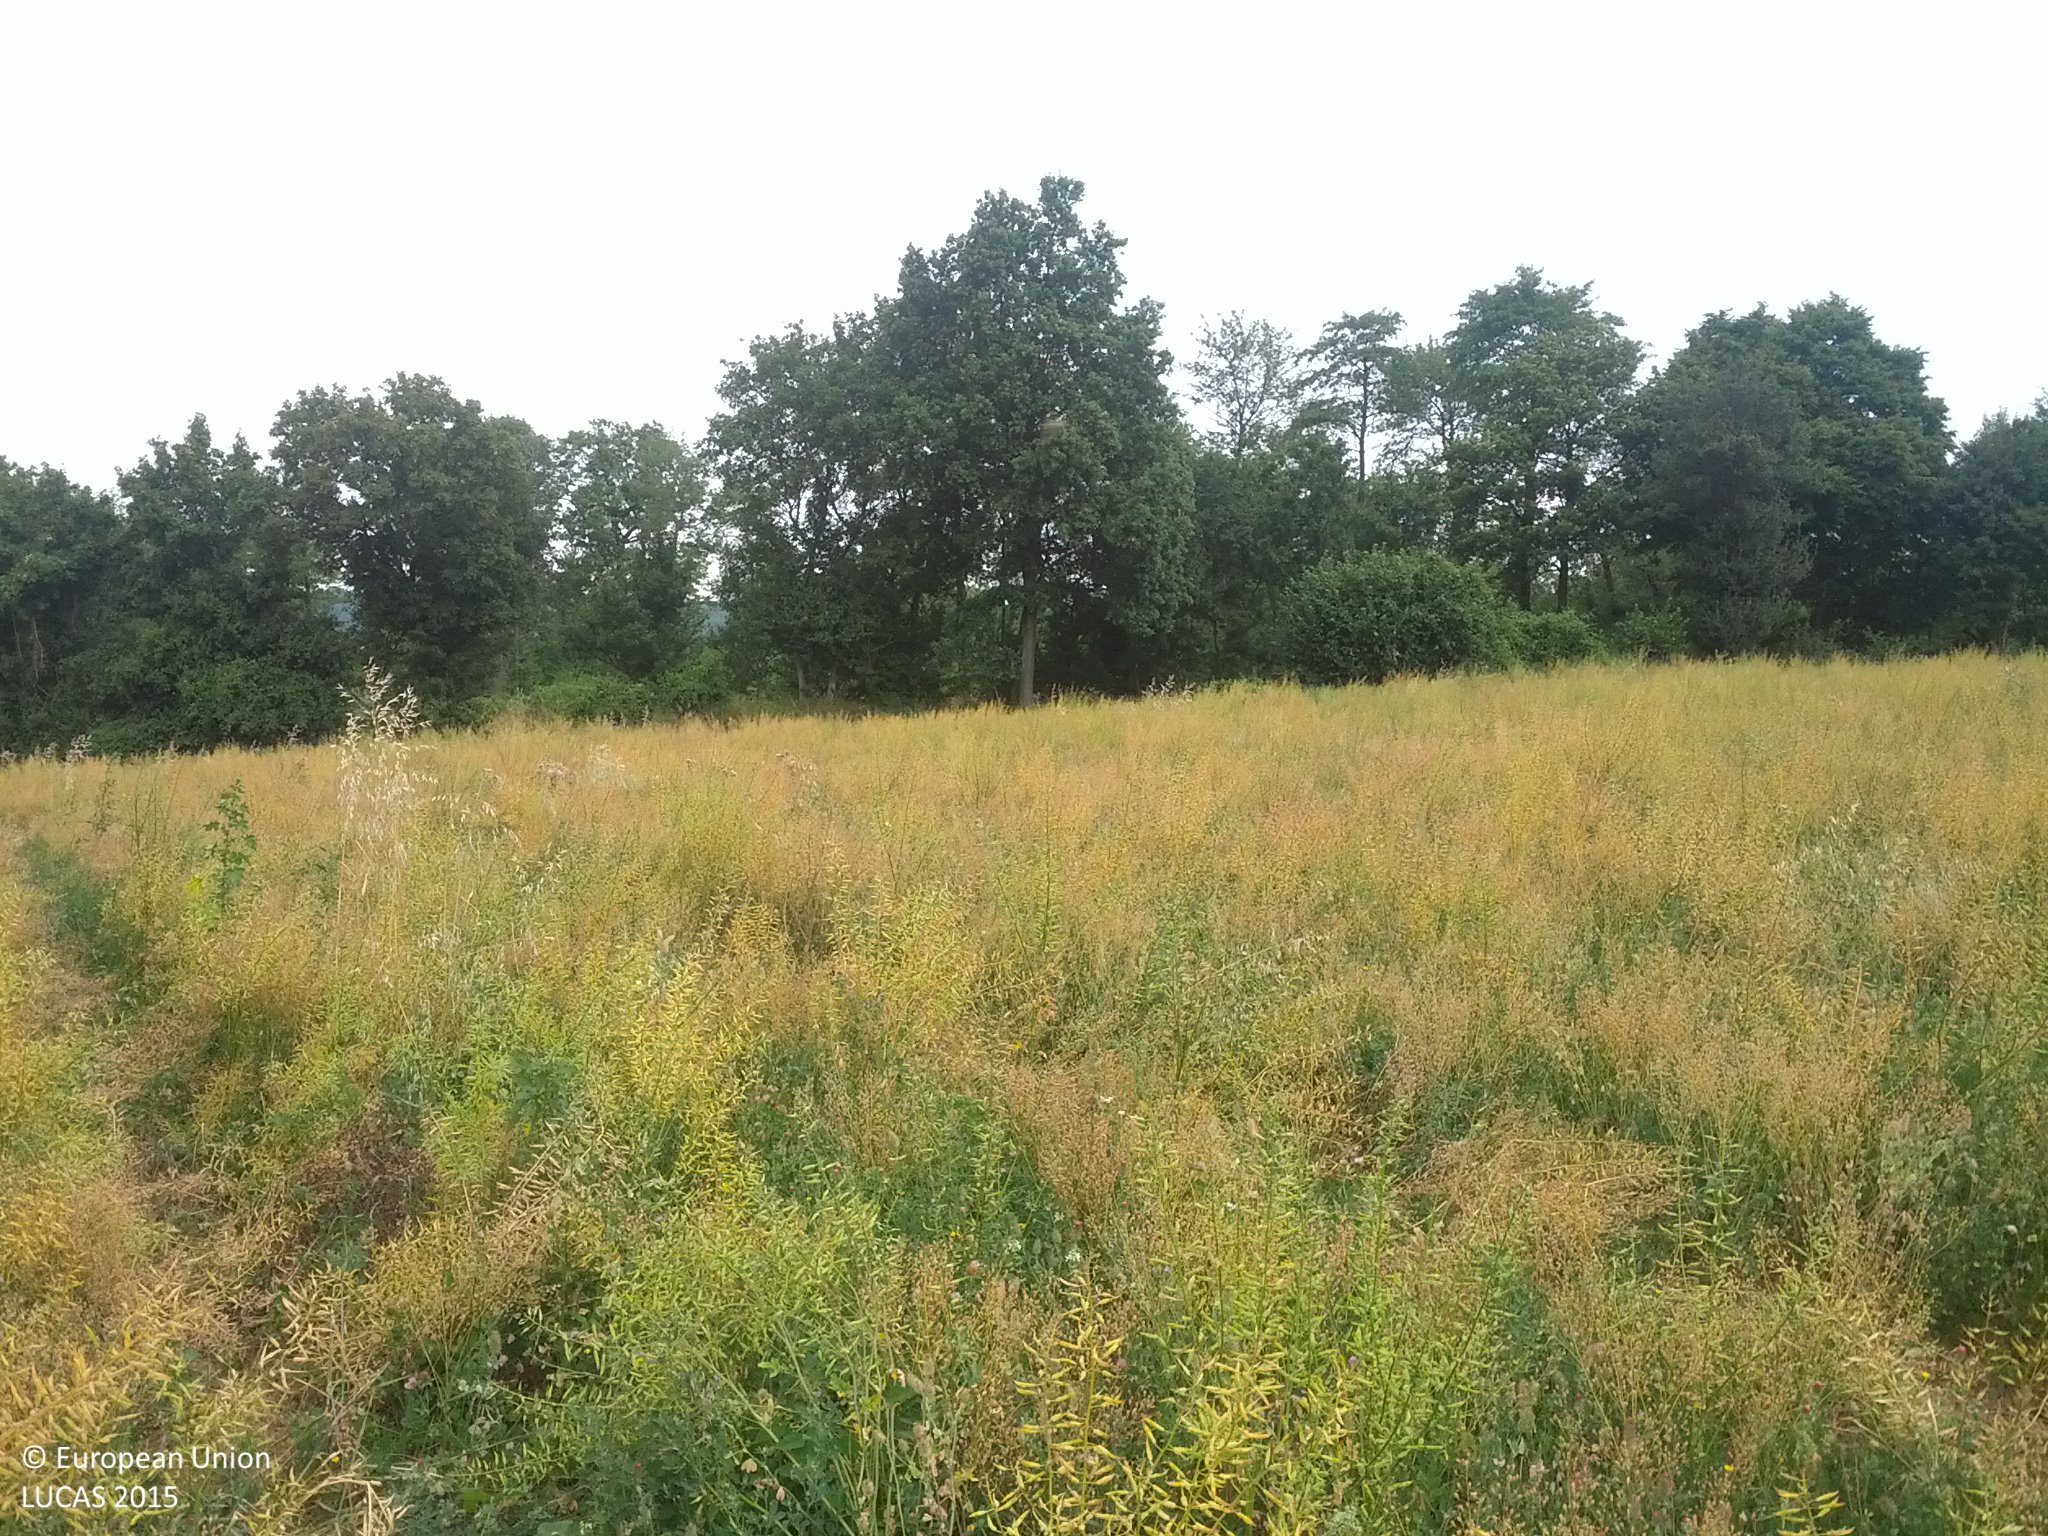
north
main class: Cropland
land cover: Other fibre and oleaginous crops
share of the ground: > 75 %
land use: Agriculture (excluding fallow land and kitchen gardens)
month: July
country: AT
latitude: 48.5202
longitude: 16.1651
